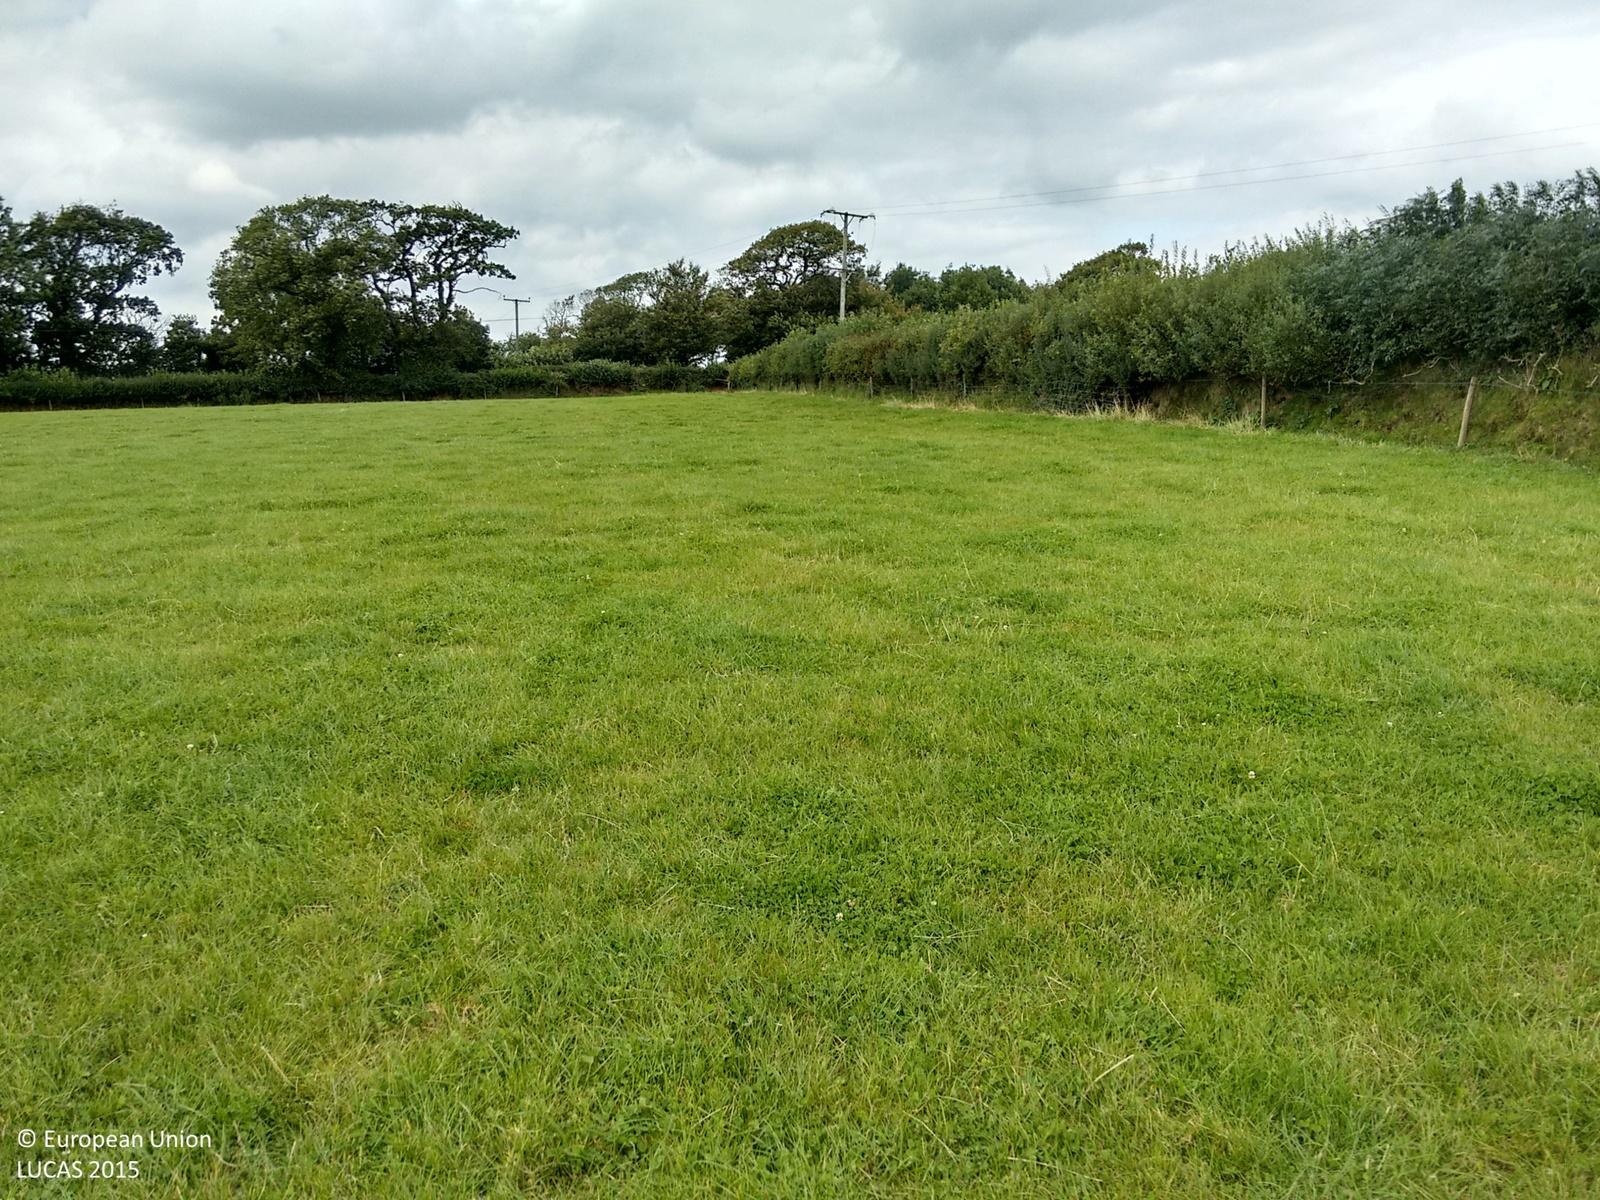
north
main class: Grassland
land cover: Grassland without tree/shrub cover
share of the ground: > 75 %
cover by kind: herbaceous plants 100 %
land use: Agriculture (excluding fallow land and kitchen gardens)
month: September
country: GB
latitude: 50.9195
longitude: -4.3116
